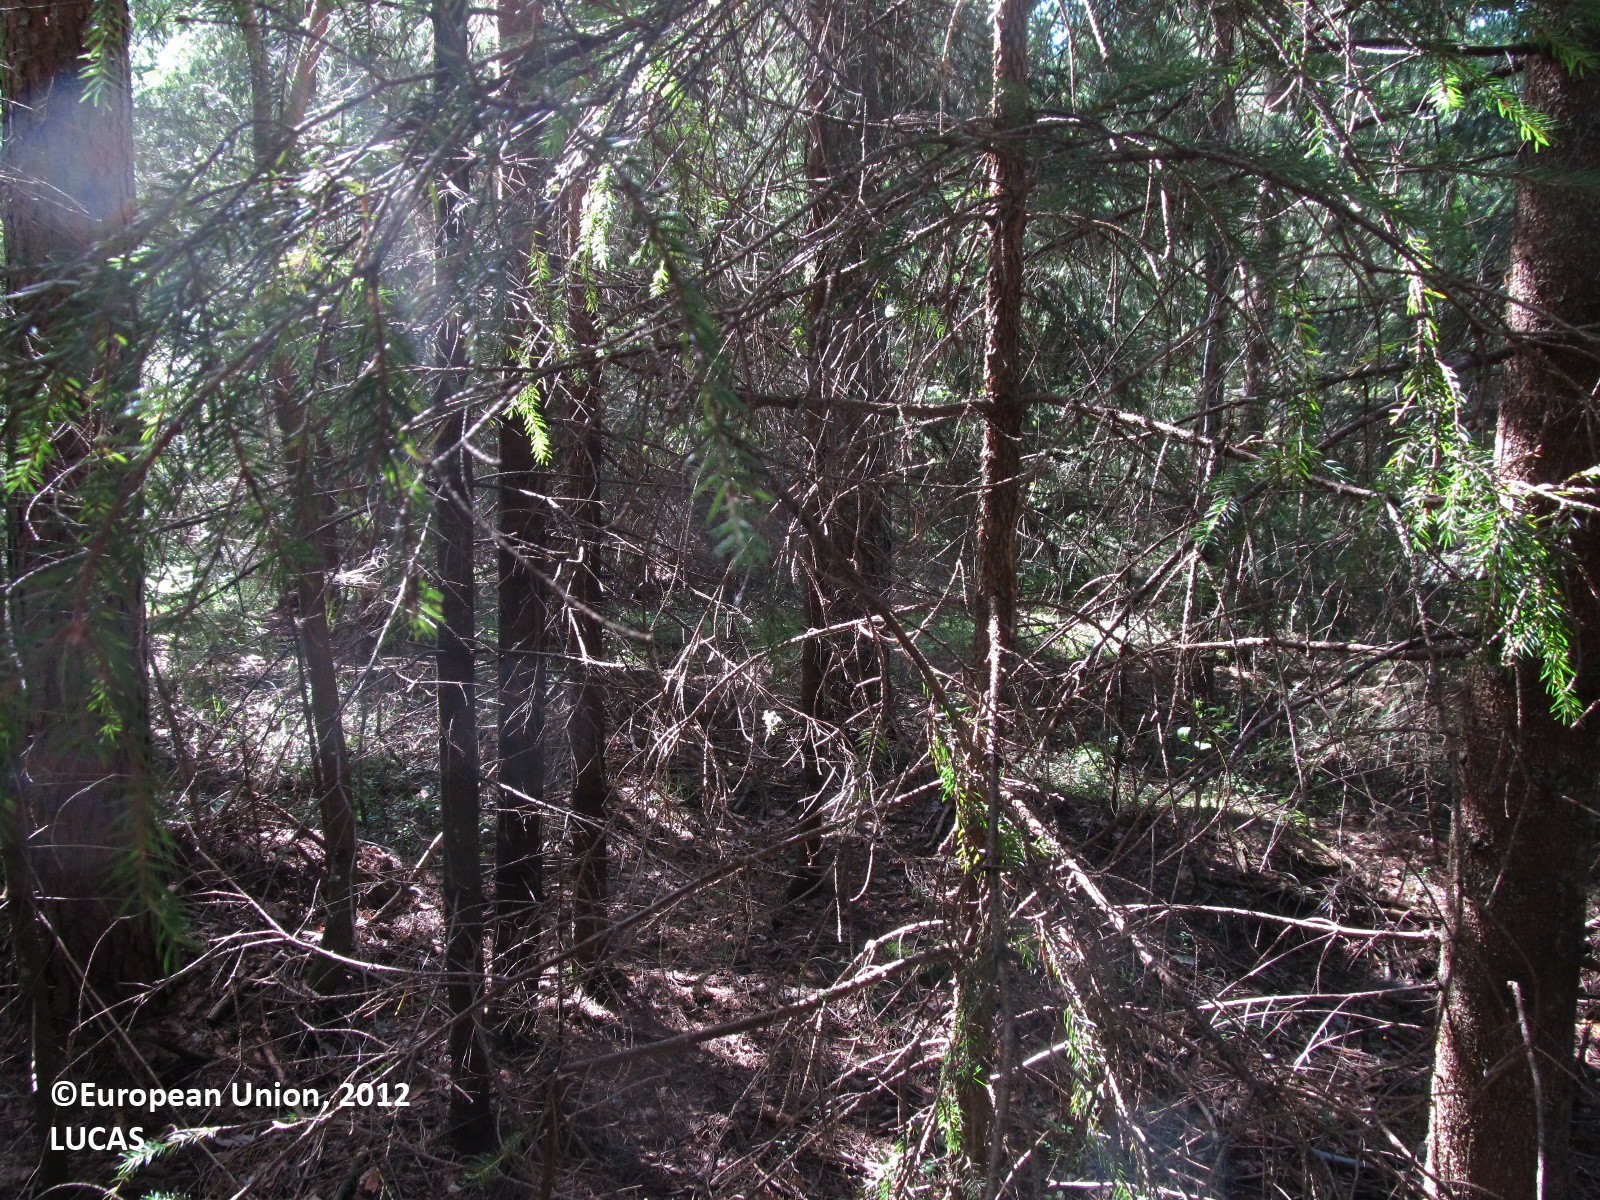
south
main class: Woodland
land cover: Spruce dominated coniferous woodland
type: boreal forest
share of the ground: 25 - 50 %
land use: Forestry
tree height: > 5 m
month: August
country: FI
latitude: 62.3274
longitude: 27.7210
